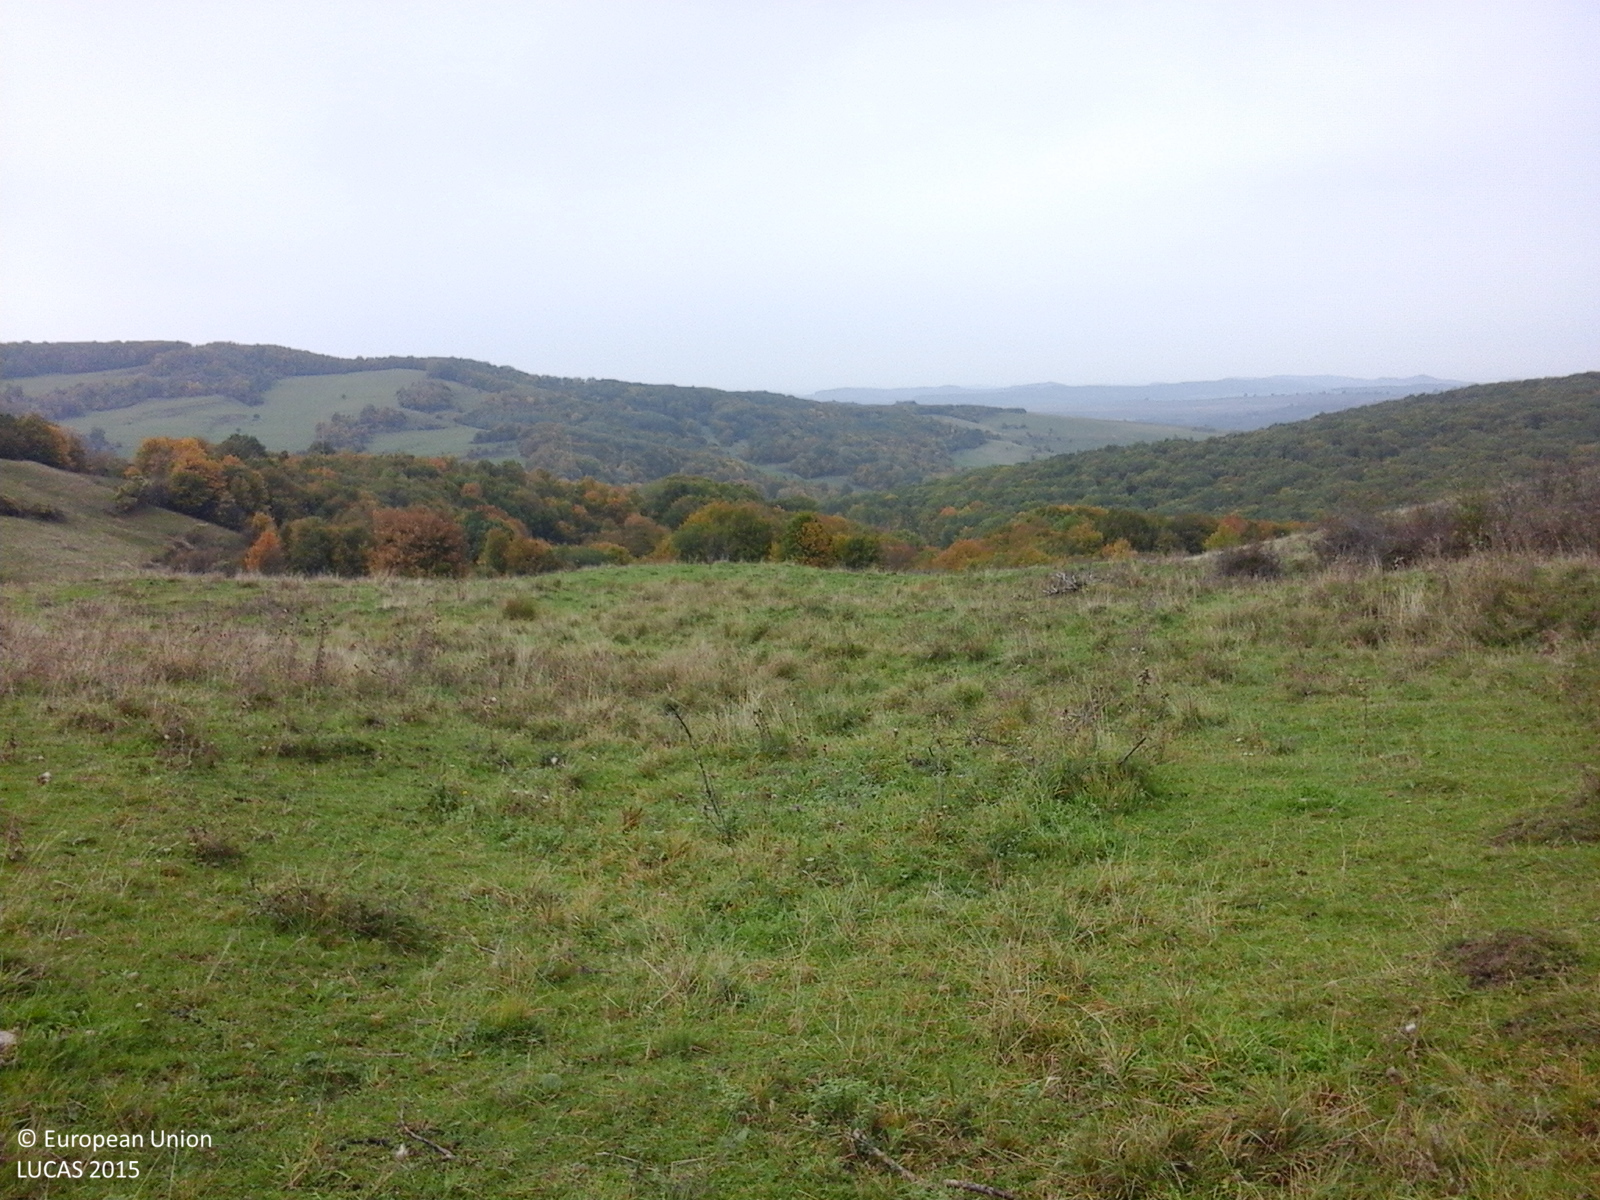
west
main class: Grassland
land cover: Grassland without tree/shrub cover
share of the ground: > 75 %
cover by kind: herbaceous plants 100 %
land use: Agriculture (excluding fallow land and kitchen gardens)
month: October
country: RO
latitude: 46.6157
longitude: 24.9172
